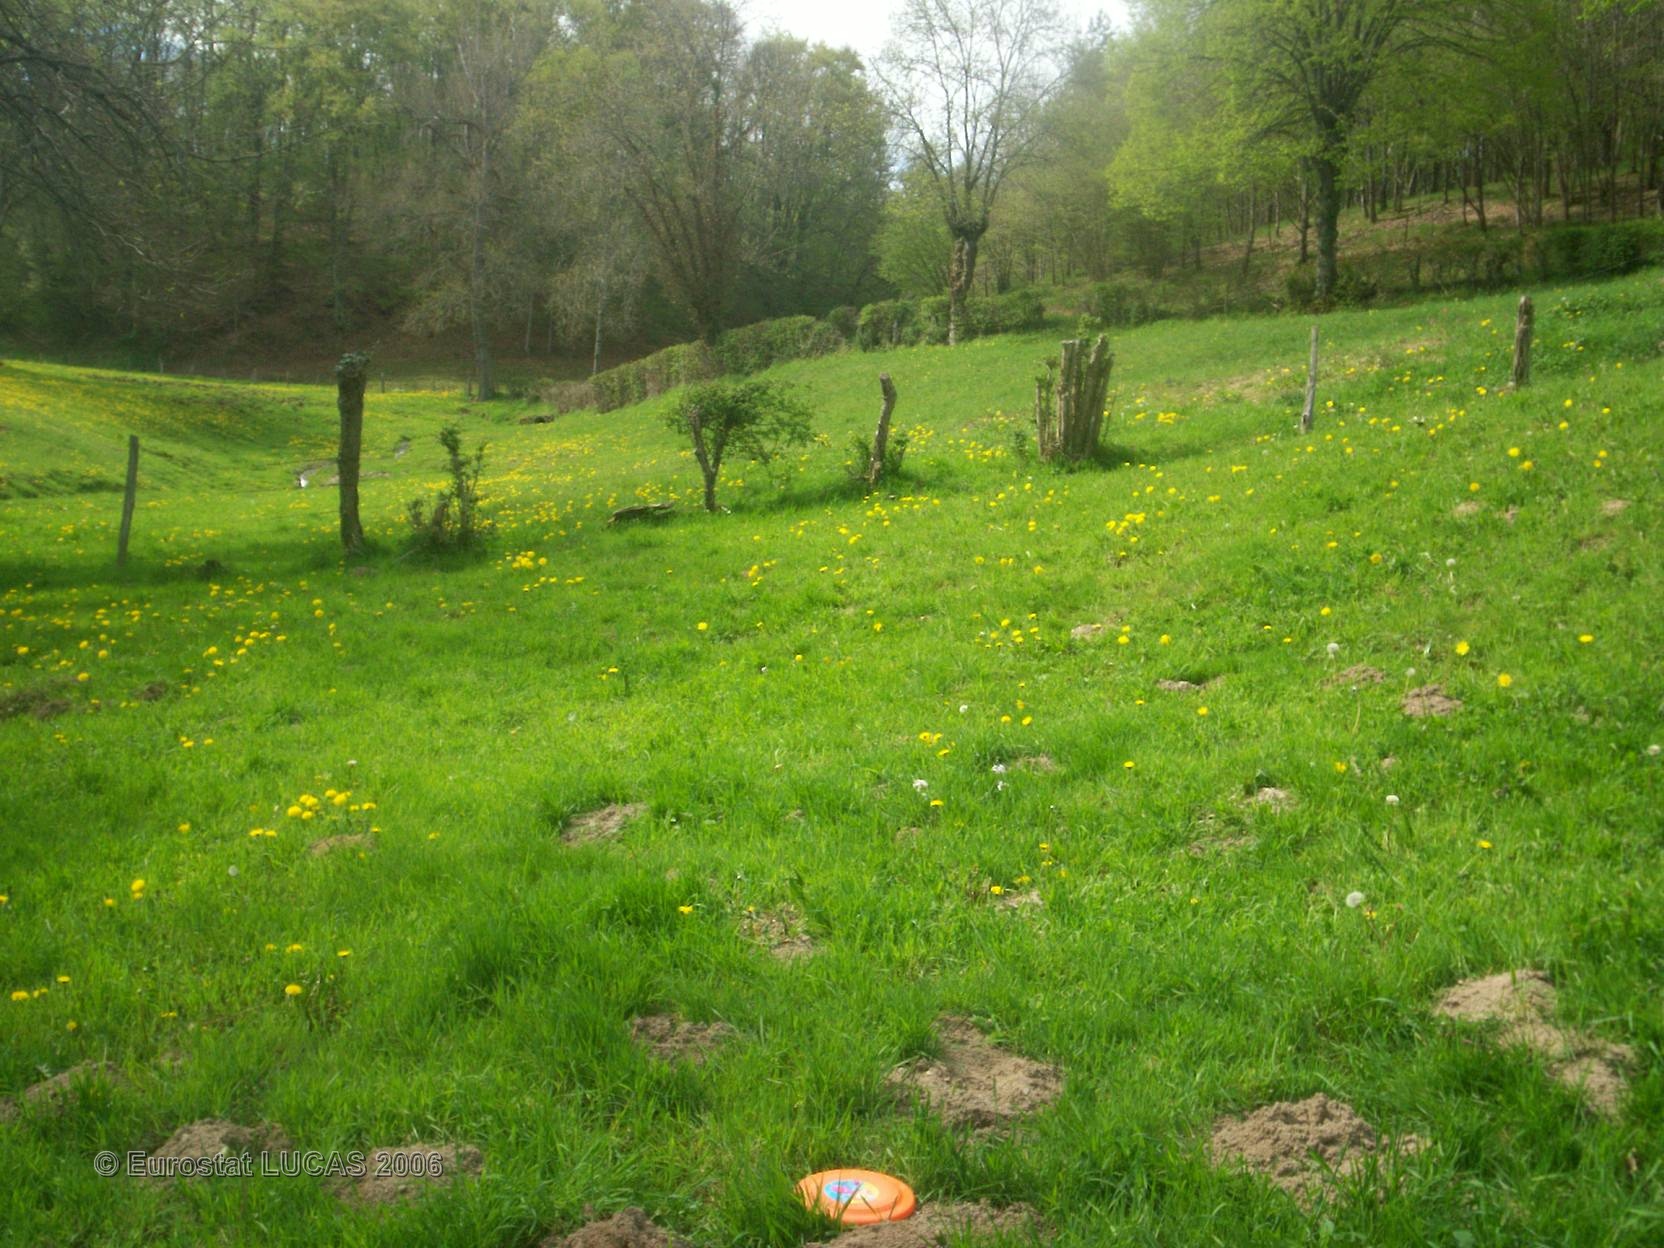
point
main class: Grassland
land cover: Grassland without tree/shrub cover
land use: Agriculture (excluding fallow land and kitchen gardens)
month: May
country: FR
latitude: 46.0072
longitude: 2.9085
